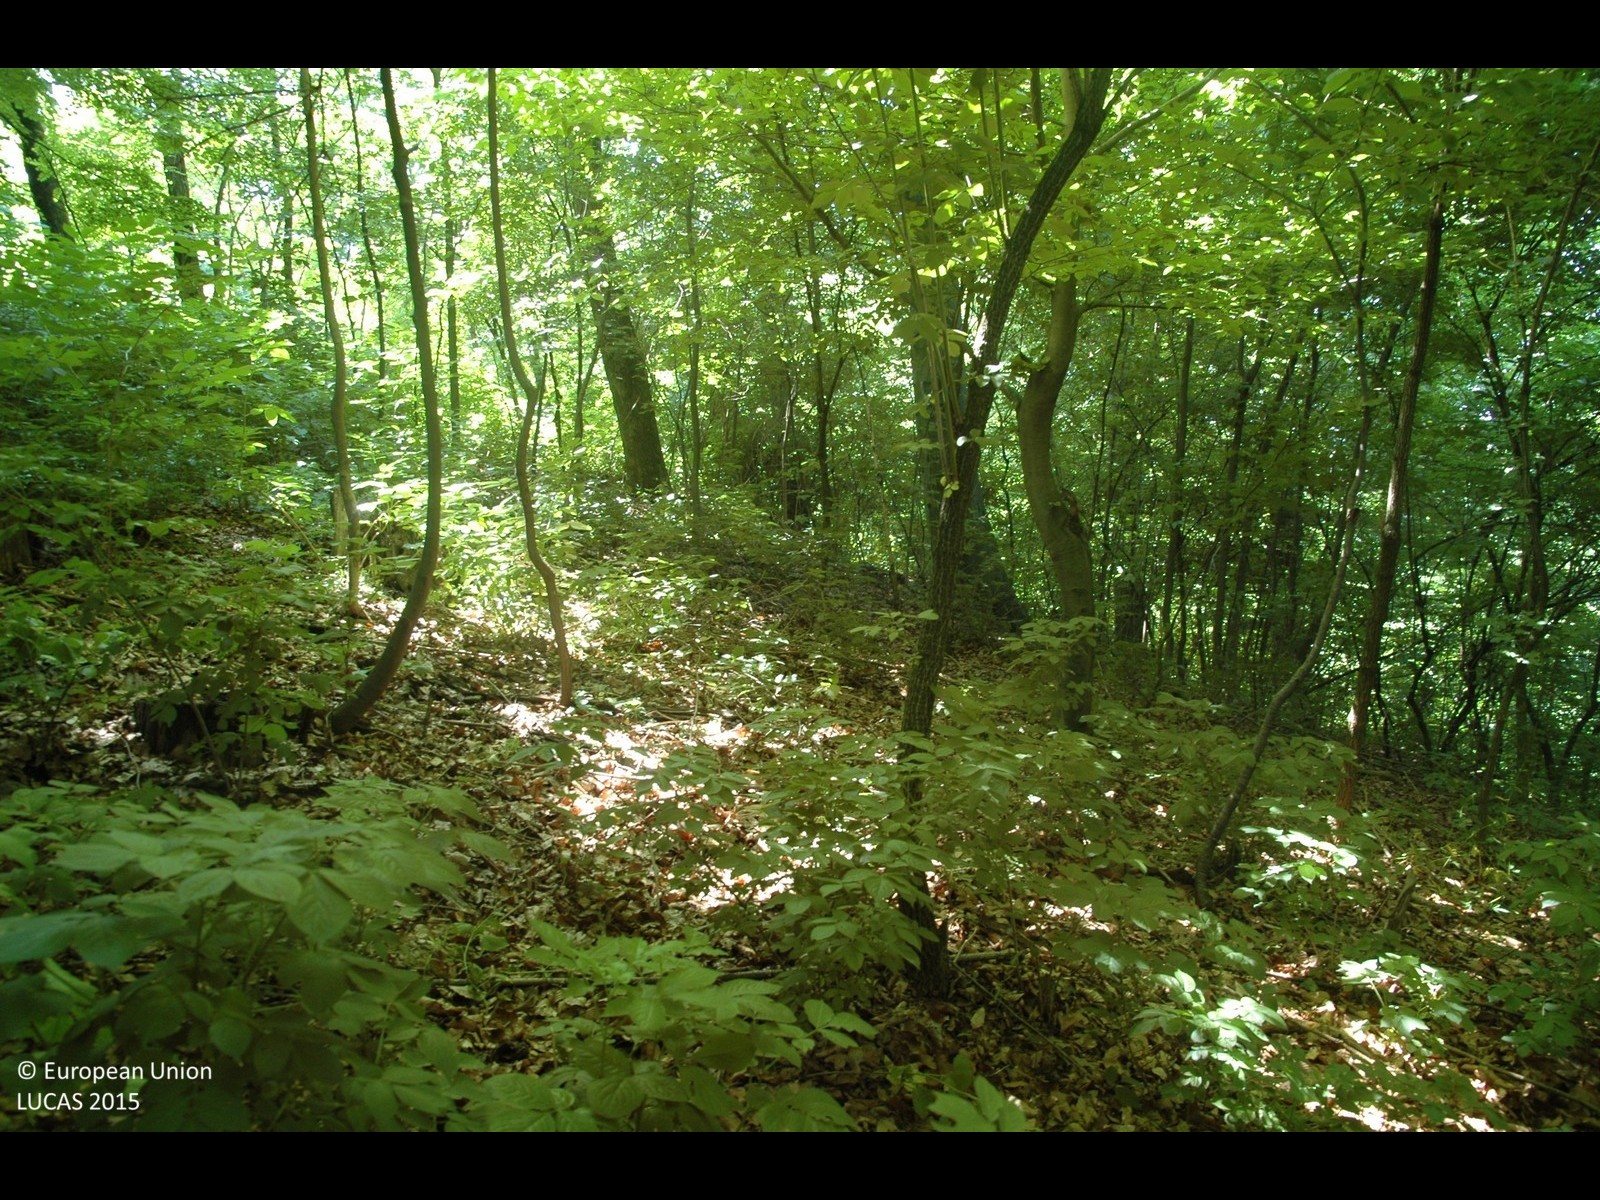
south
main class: Woodland
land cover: Broadleaved woodland
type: beech forest
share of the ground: > 75 %
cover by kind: broadleaved forest trees 90 %, shrubs 5 %, herbaceous plants 5 %
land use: Forestry
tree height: > 5 m
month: May
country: HR
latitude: 46.5043
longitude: 16.3731
